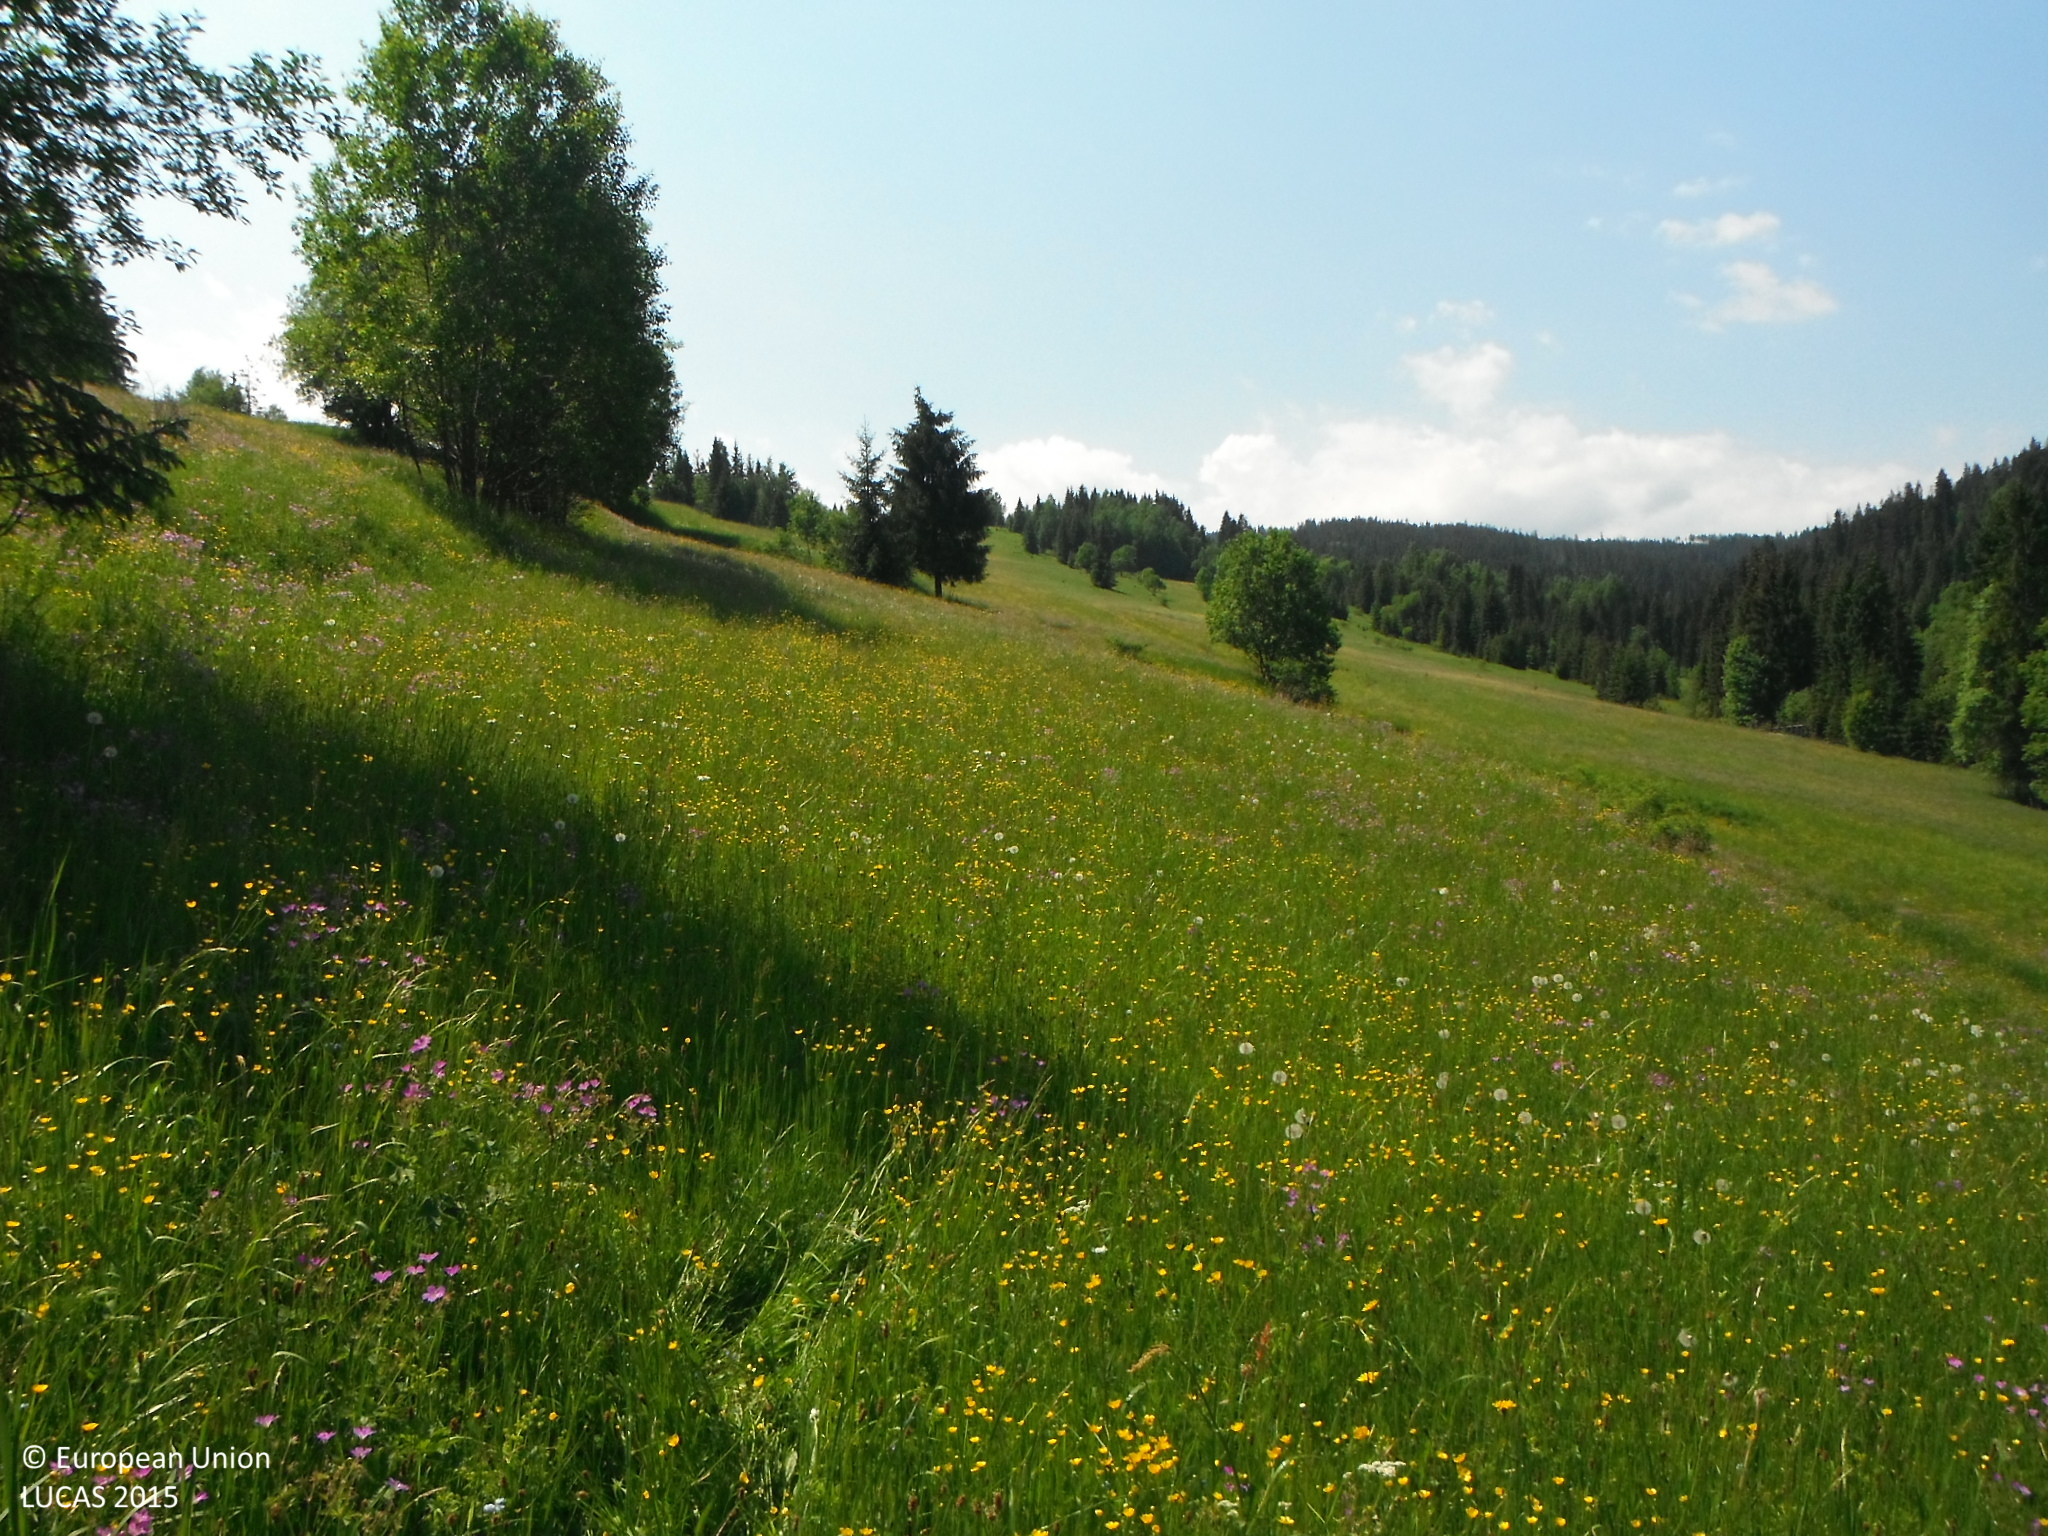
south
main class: Grassland
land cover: Grassland with sparse tree/shrub cover
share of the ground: > 75 %
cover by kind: herbaceous plants 90 %, broadleaved forest trees 5 %, shrubs 5 %
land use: Agriculture (excluding fallow land and kitchen gardens)
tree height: < 5 m
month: June
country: SK
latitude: 49.3266
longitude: 20.2015
